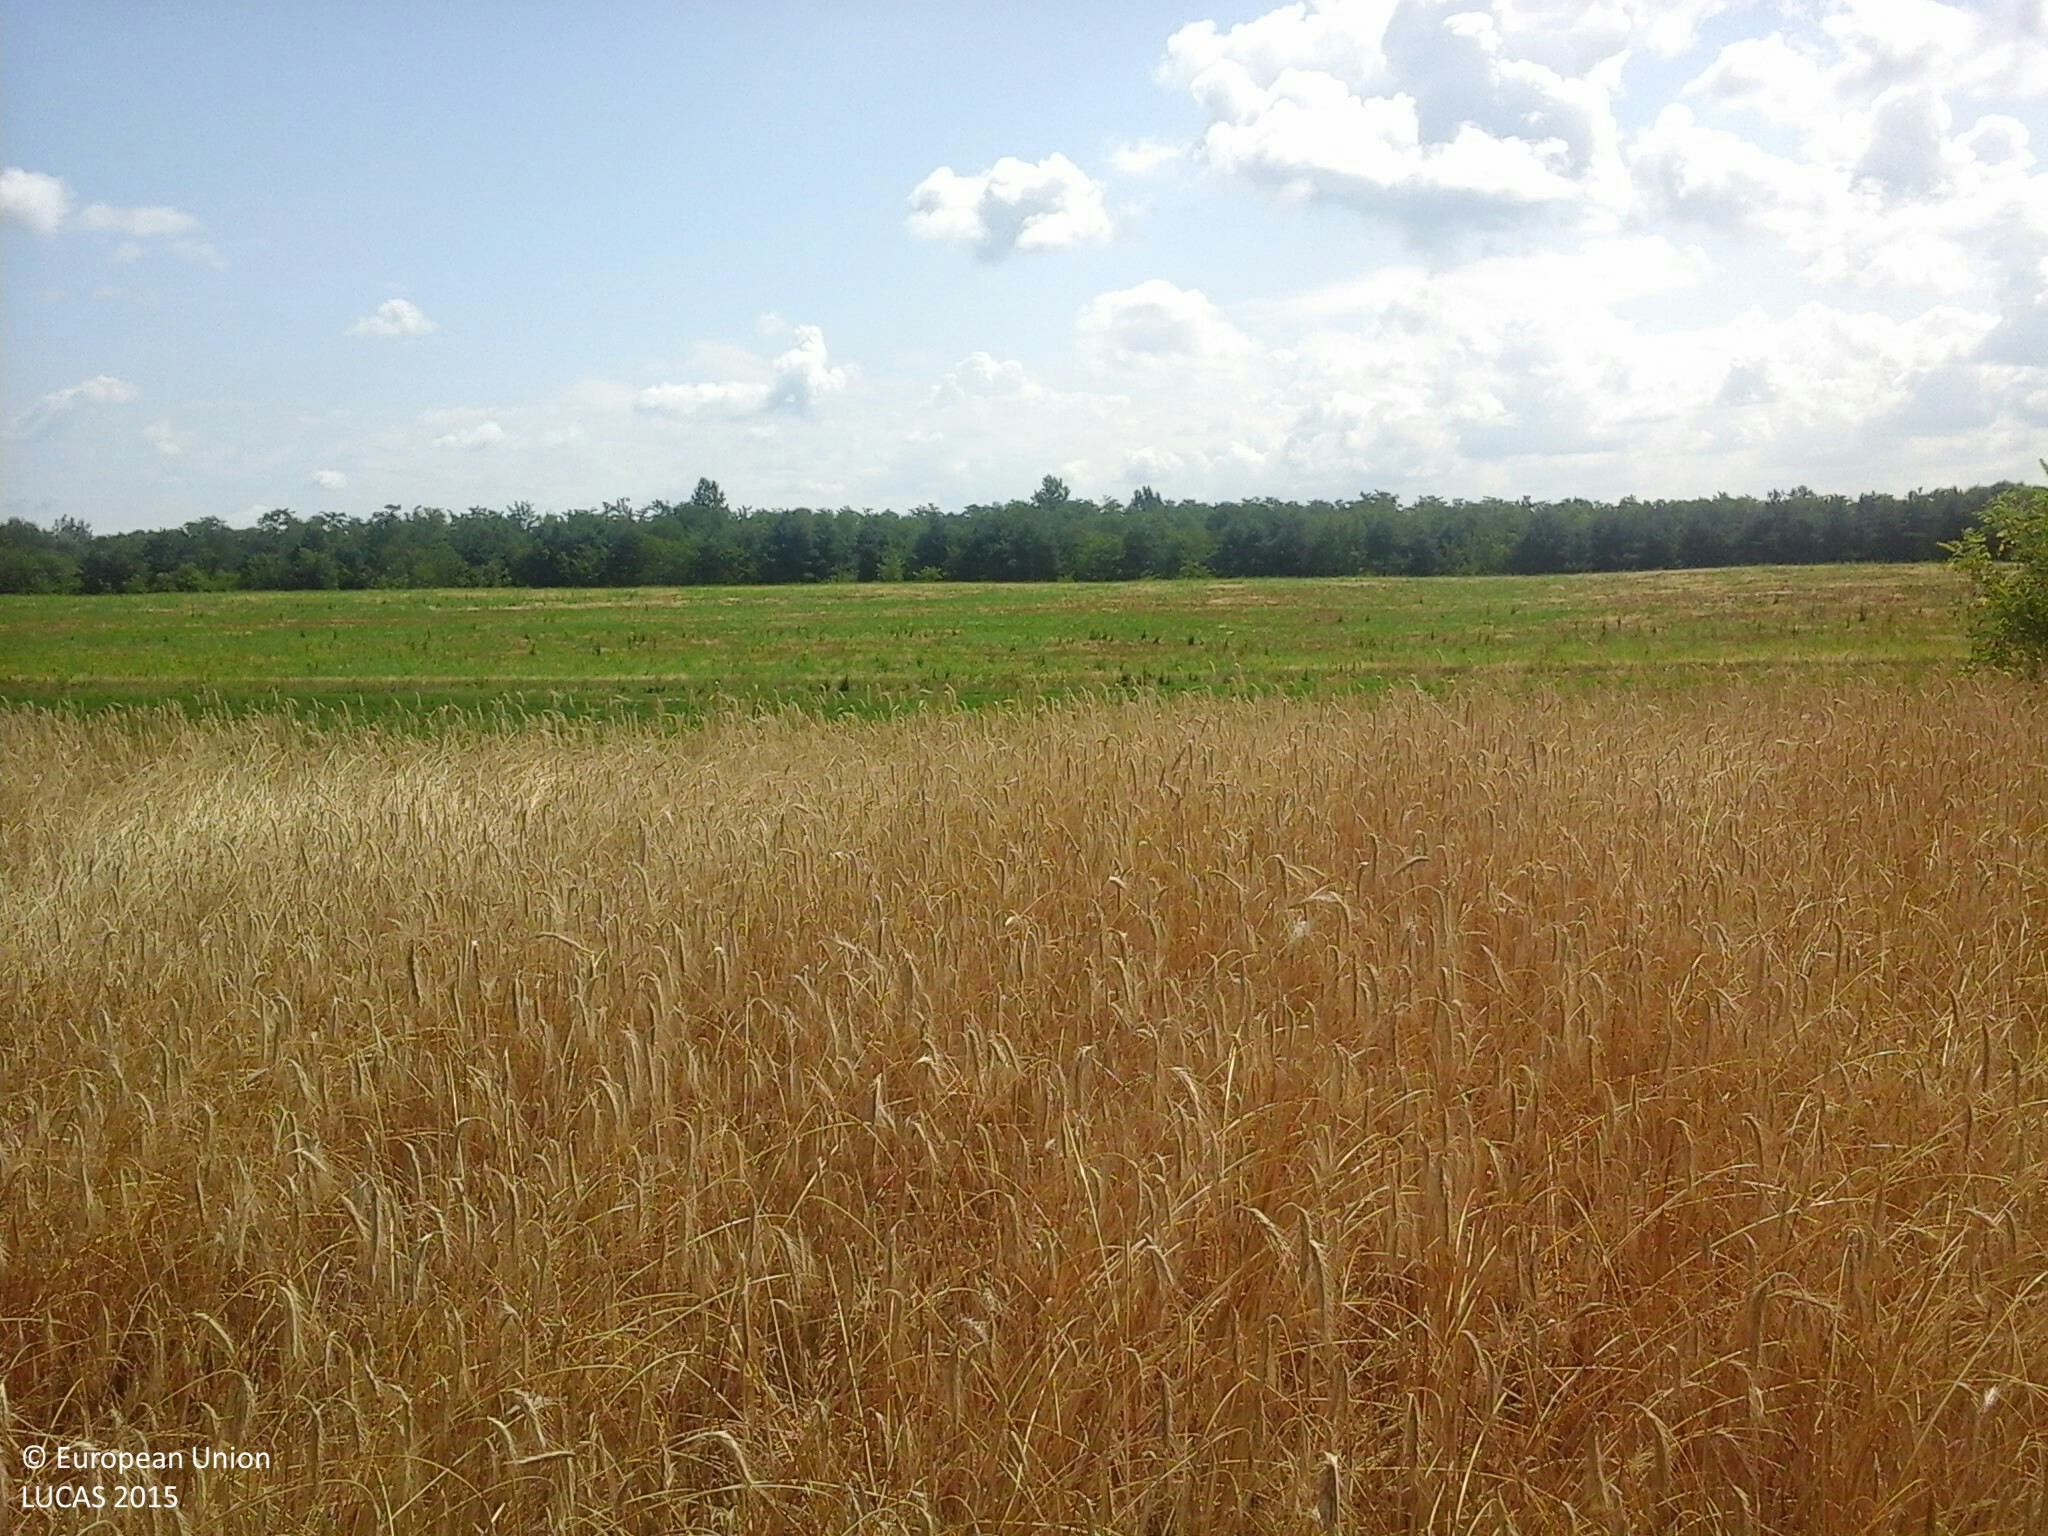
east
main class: Cropland
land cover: Triticale
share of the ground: > 75 %
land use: Agriculture (excluding fallow land and kitchen gardens)
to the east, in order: Triticale; Spontaneously vegetated surfaces; Sunflower; Spontaneously vegetated surfaces
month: July
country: HU
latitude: 47.8815
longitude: 22.2641
